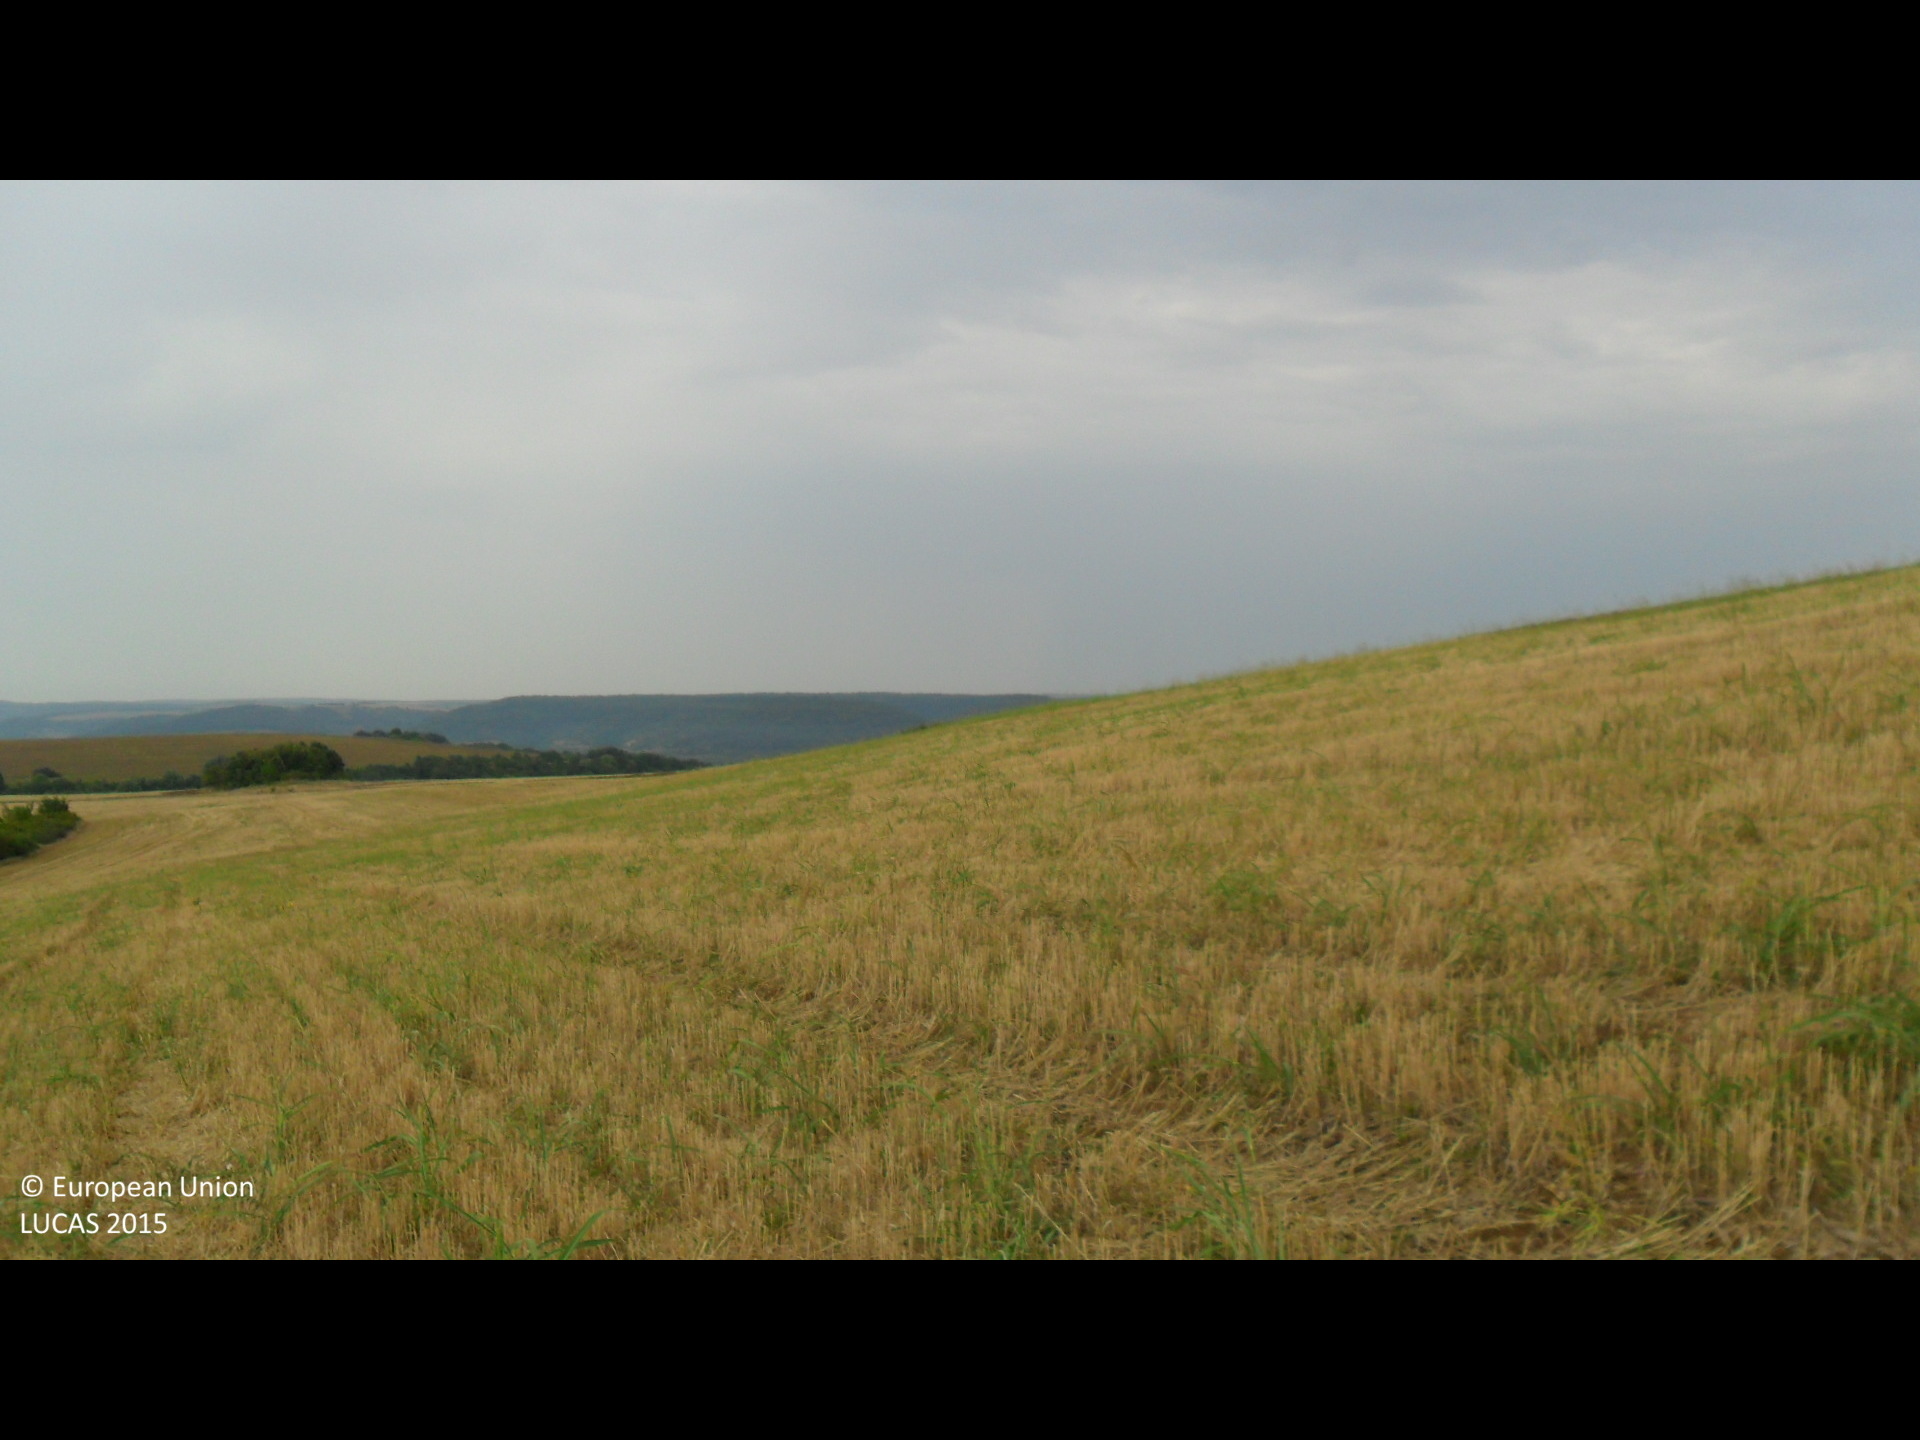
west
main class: Cropland
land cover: Barley
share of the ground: > 75 %
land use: Agriculture (excluding fallow land and kitchen gardens)
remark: Harvested field
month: August
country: BG
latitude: 43.4708
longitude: 26.2042
